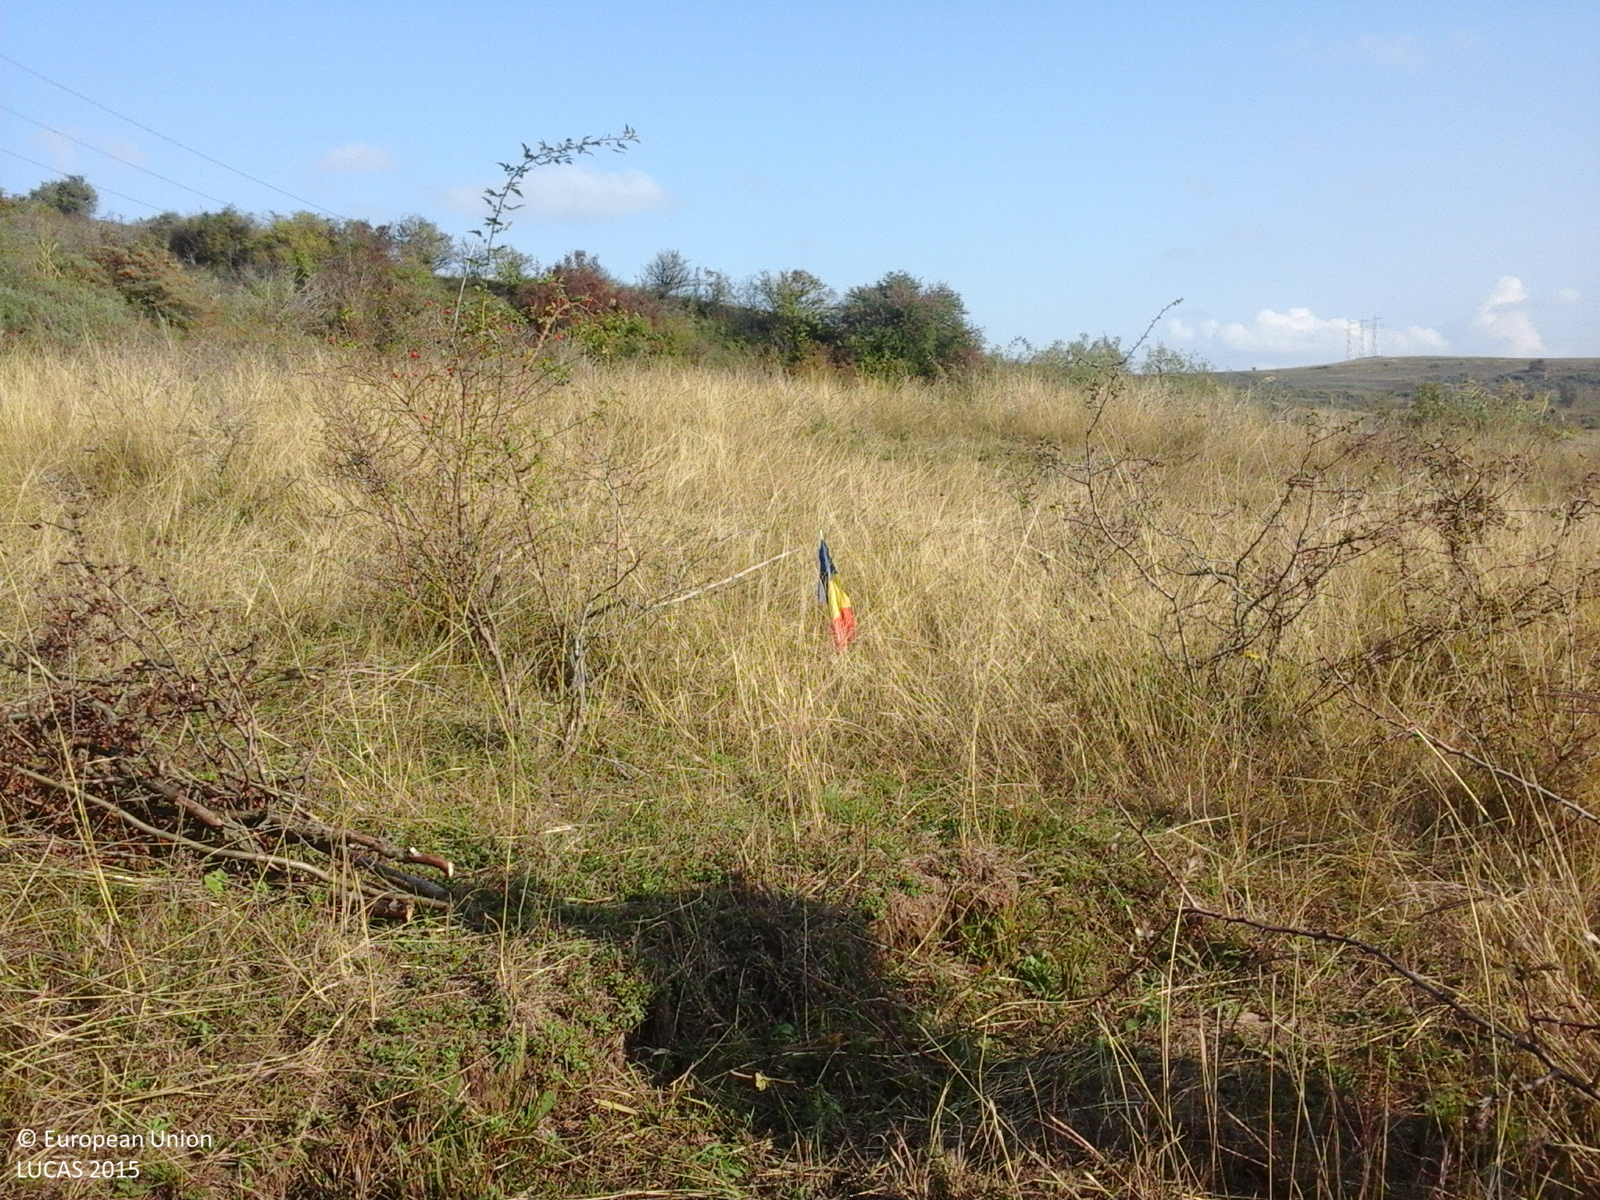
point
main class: Grassland
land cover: Grassland with sparse tree/shrub cover
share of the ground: > 75 %
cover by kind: herbaceous plants 95 %, broadleaved forest trees 5 %
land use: Agriculture (excluding fallow land and kitchen gardens)
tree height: < 5 m
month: October
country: RO
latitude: 46.3546
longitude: 24.1532
